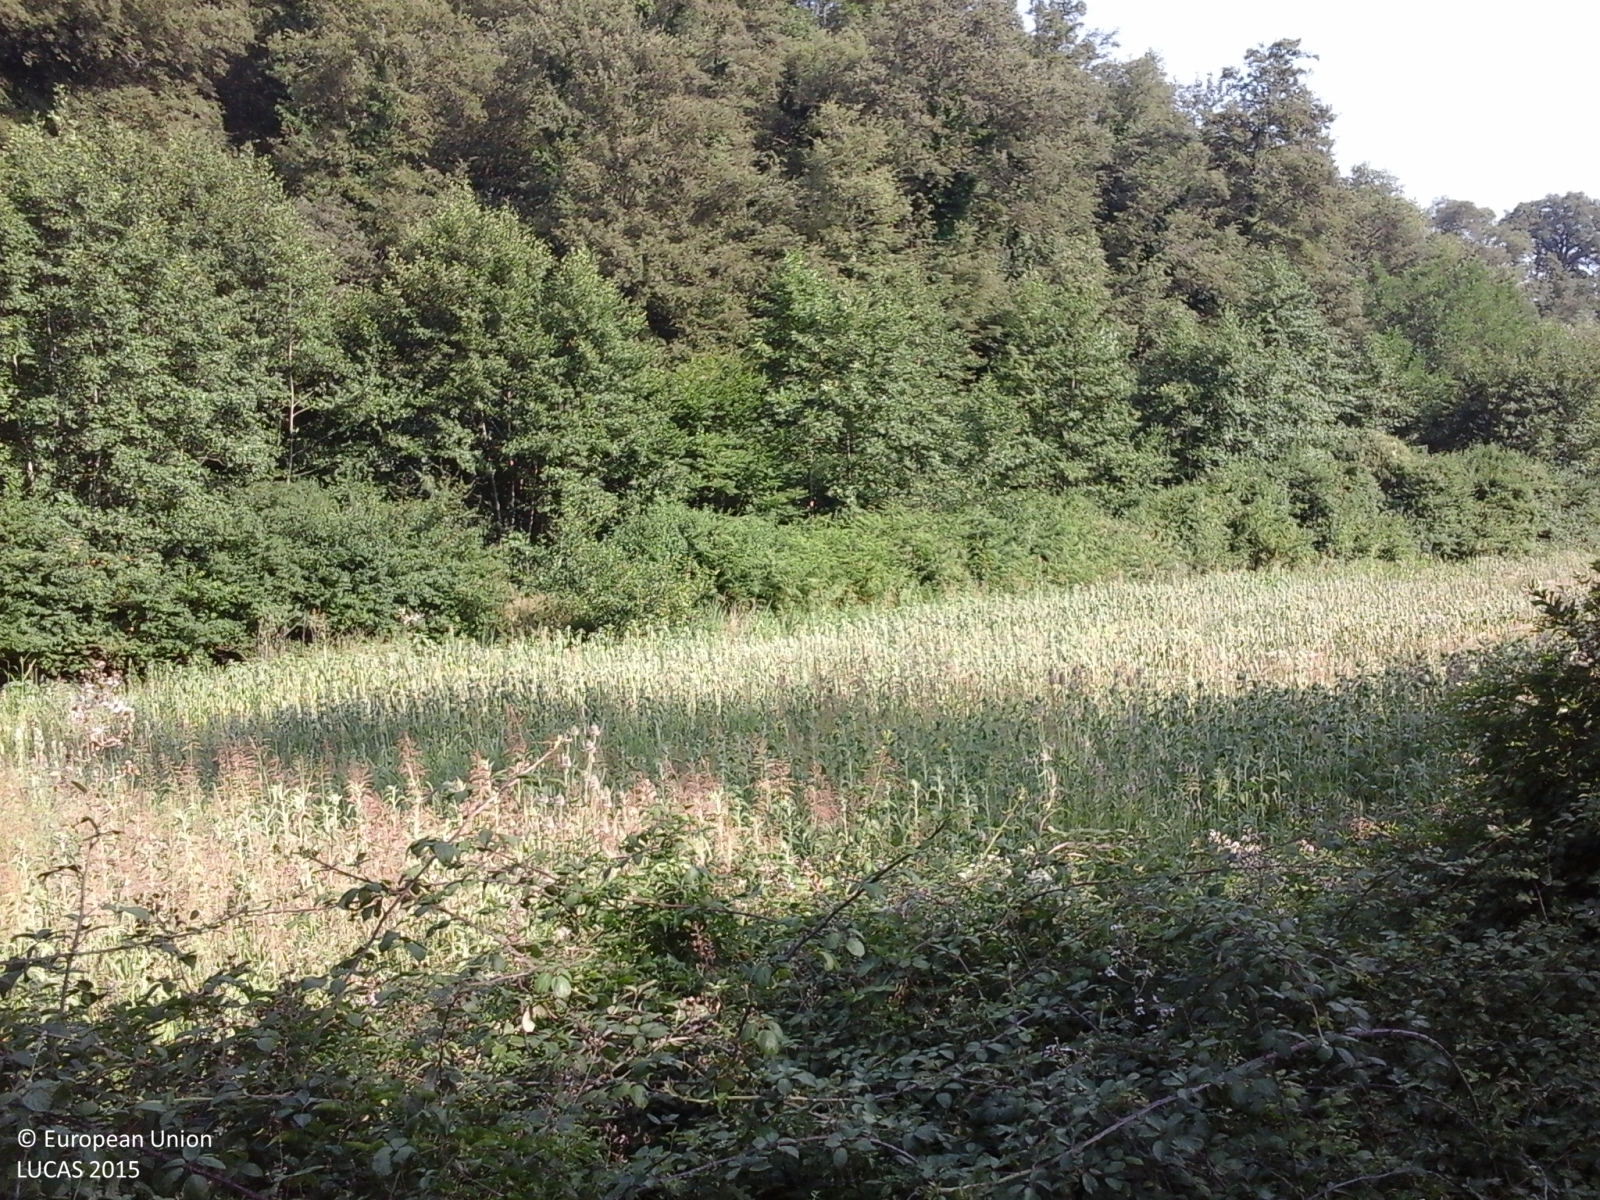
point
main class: Cropland
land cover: Sunflower
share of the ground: > 75 %
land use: Agriculture (excluding fallow land and kitchen gardens)
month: July
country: IT
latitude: 43.3463
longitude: 11.5623
